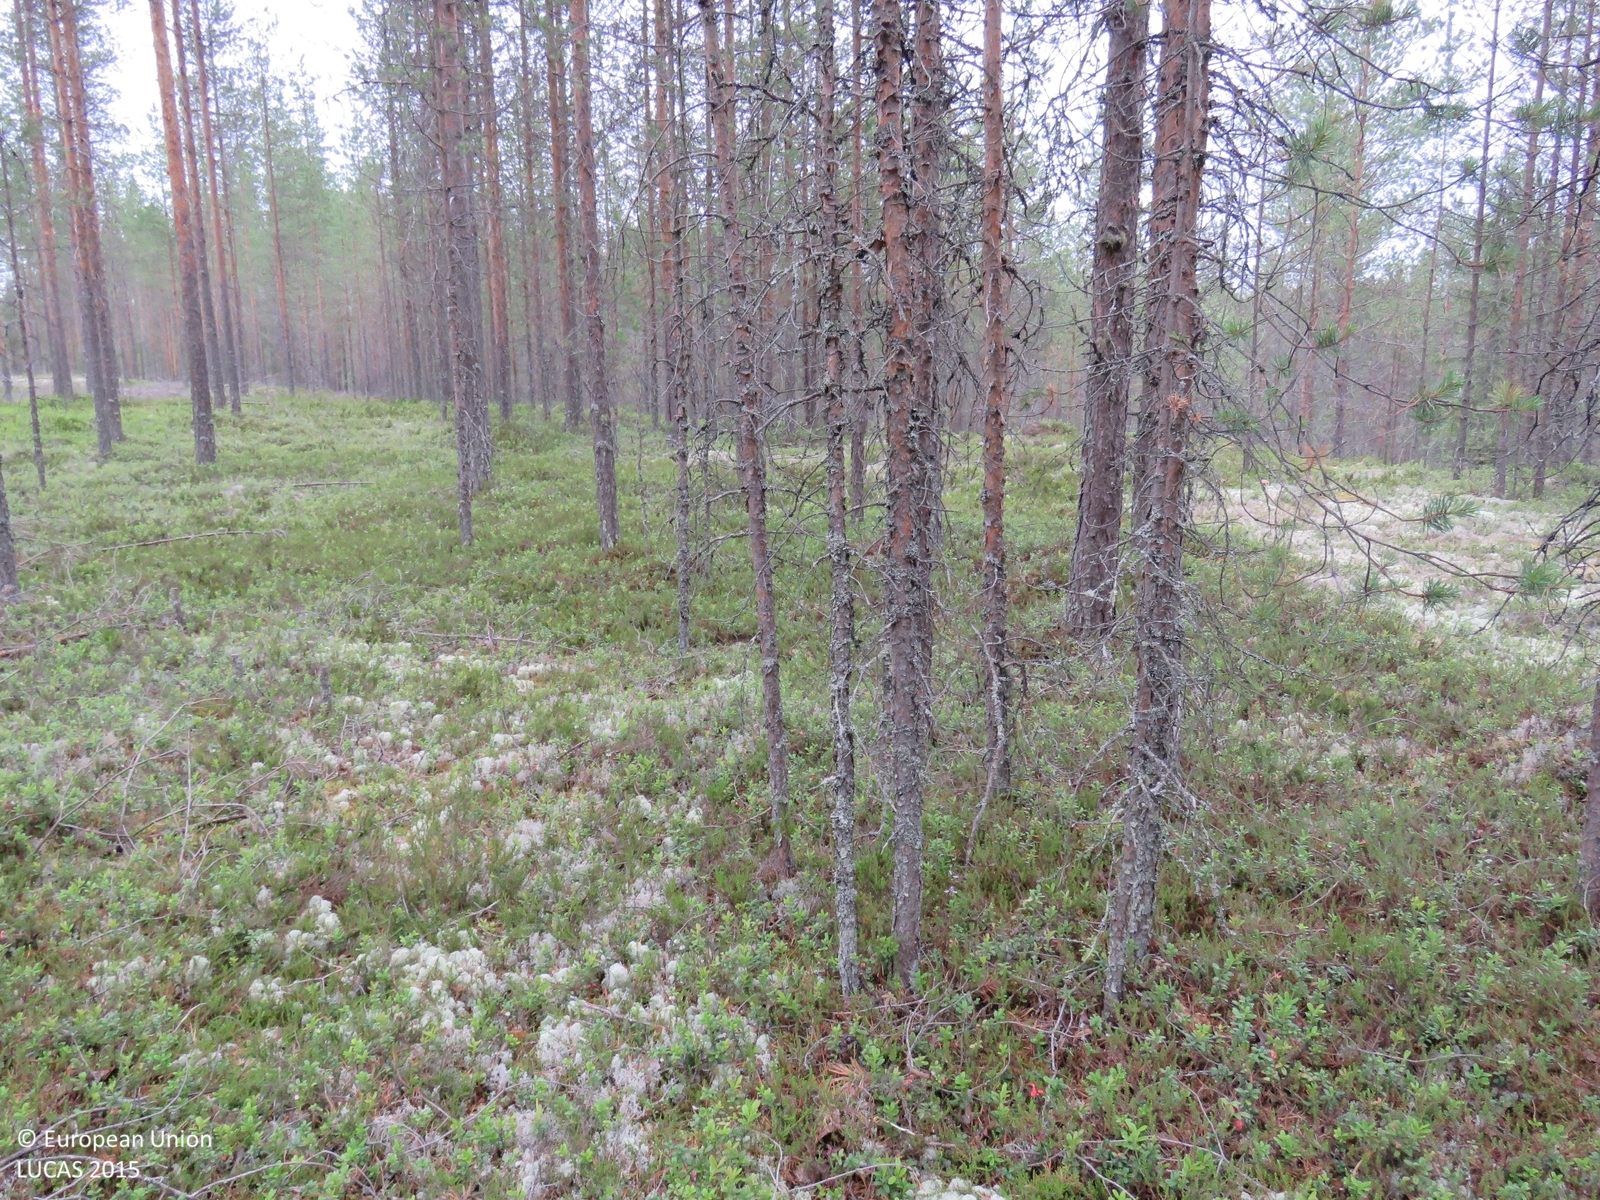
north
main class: Woodland
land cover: Pine dominated coniferous woodland
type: boreal forest
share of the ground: > 75 %
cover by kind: coniferous forest trees 80 %, shrubs 10 %, lichens and mosses 10 %
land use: Forestry
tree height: > 5 m
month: July
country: FI
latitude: 64.3241
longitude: 26.3086
